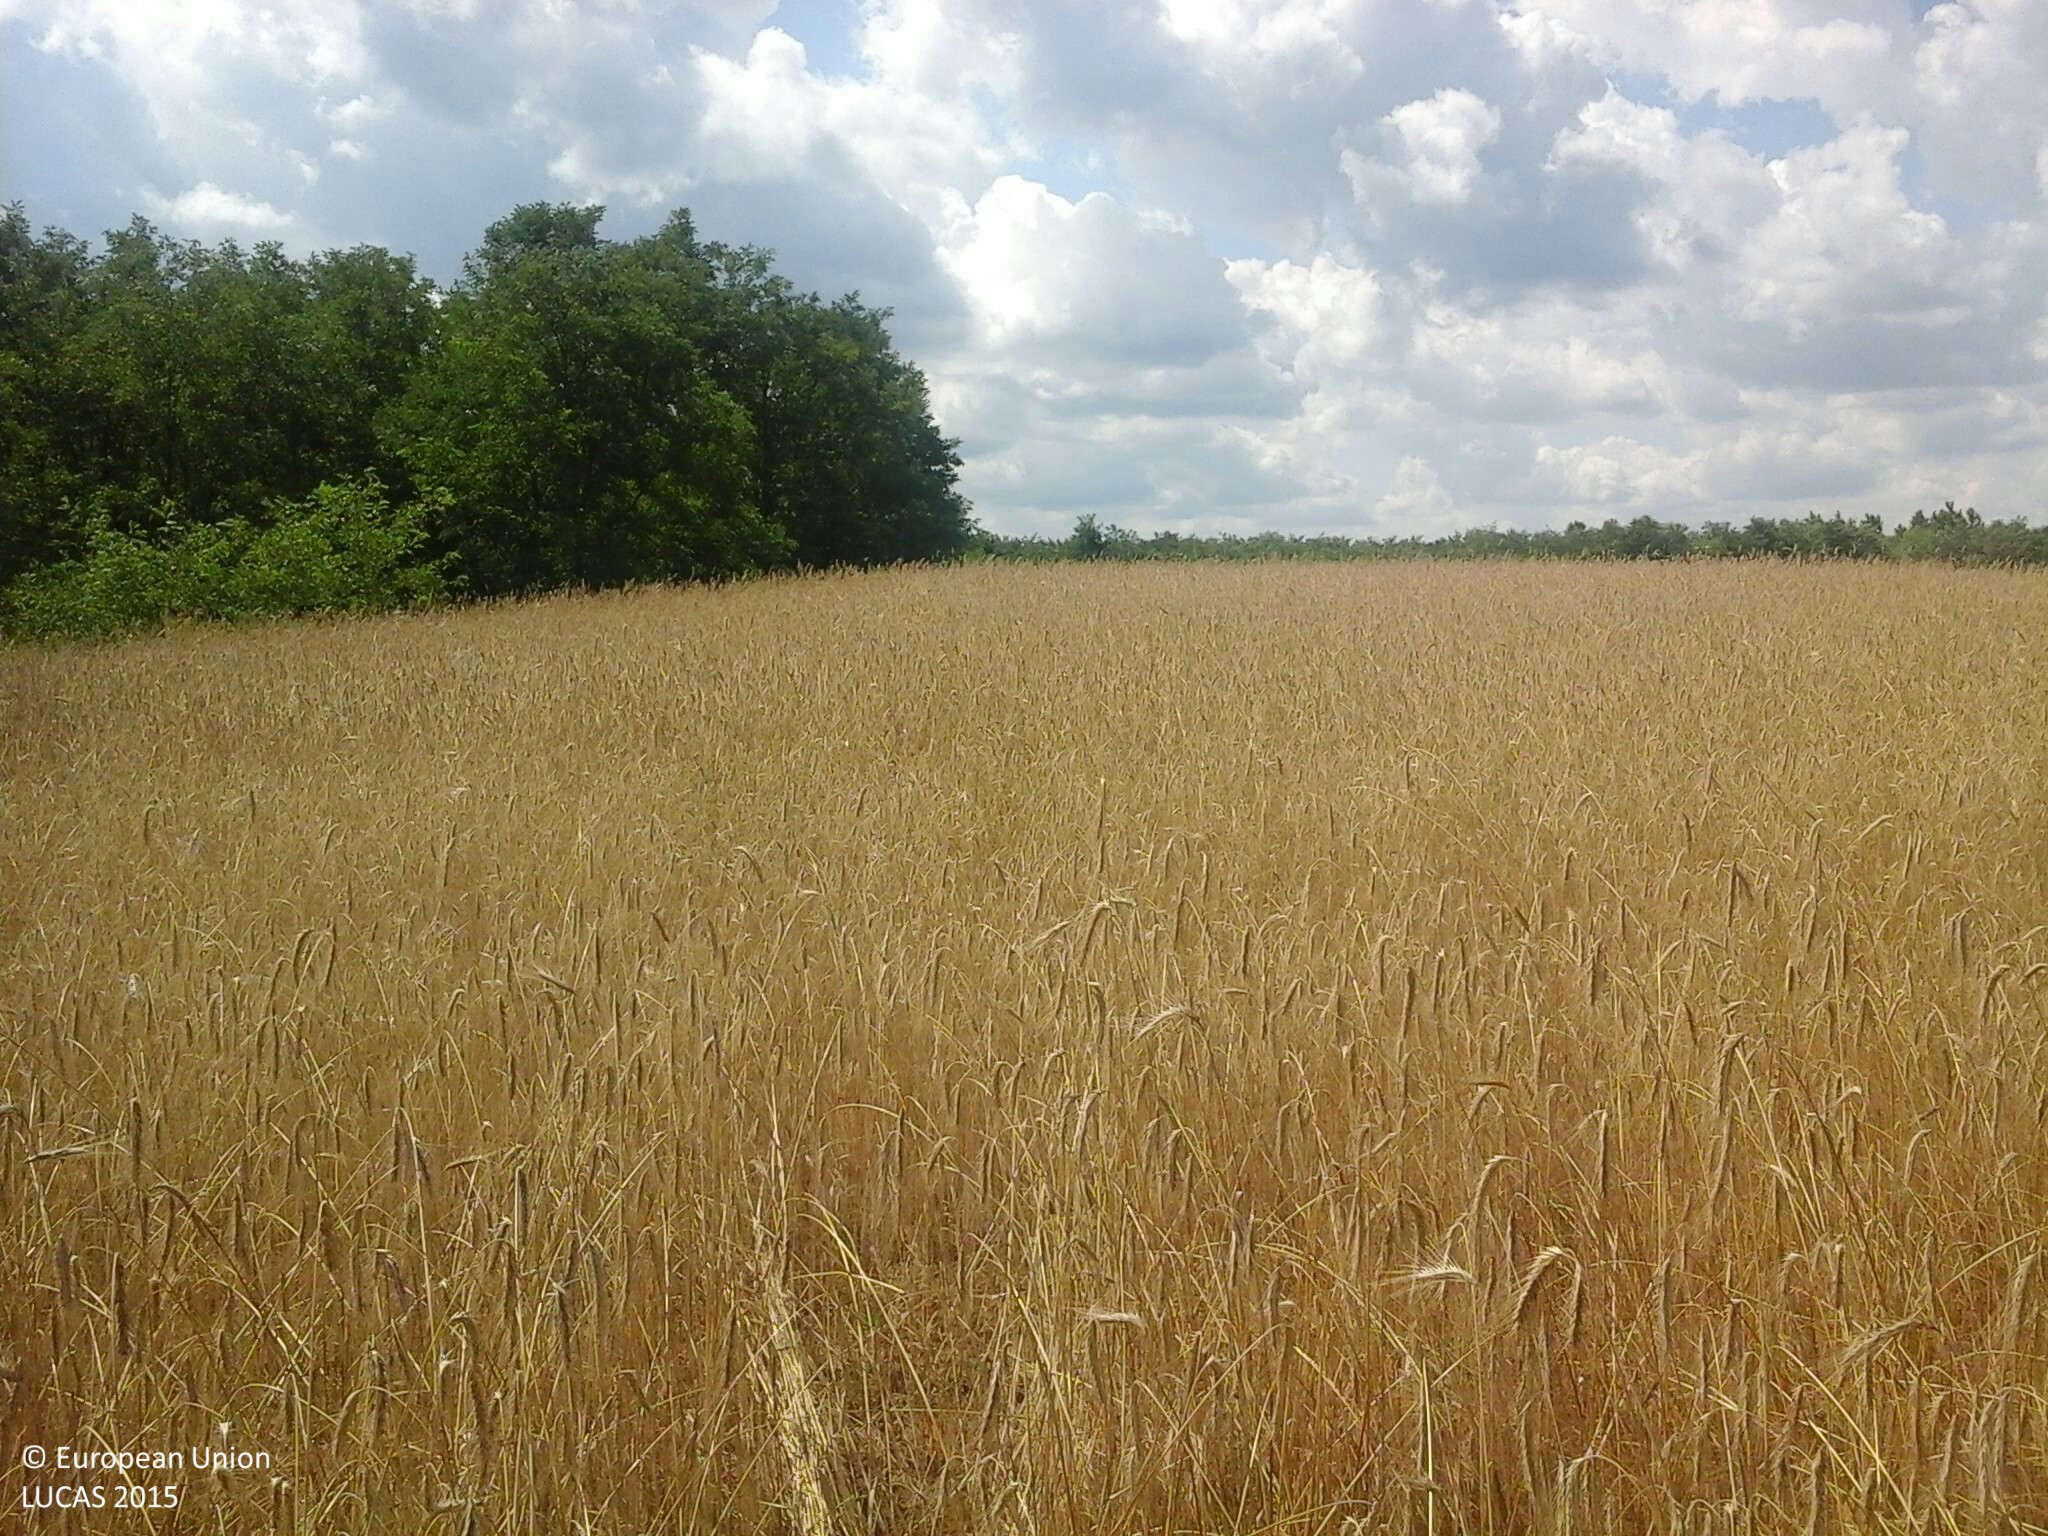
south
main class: Cropland
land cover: Triticale
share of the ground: > 75 %
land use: Agriculture (excluding fallow land and kitchen gardens)
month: July
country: HU
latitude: 47.8815
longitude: 22.2641
